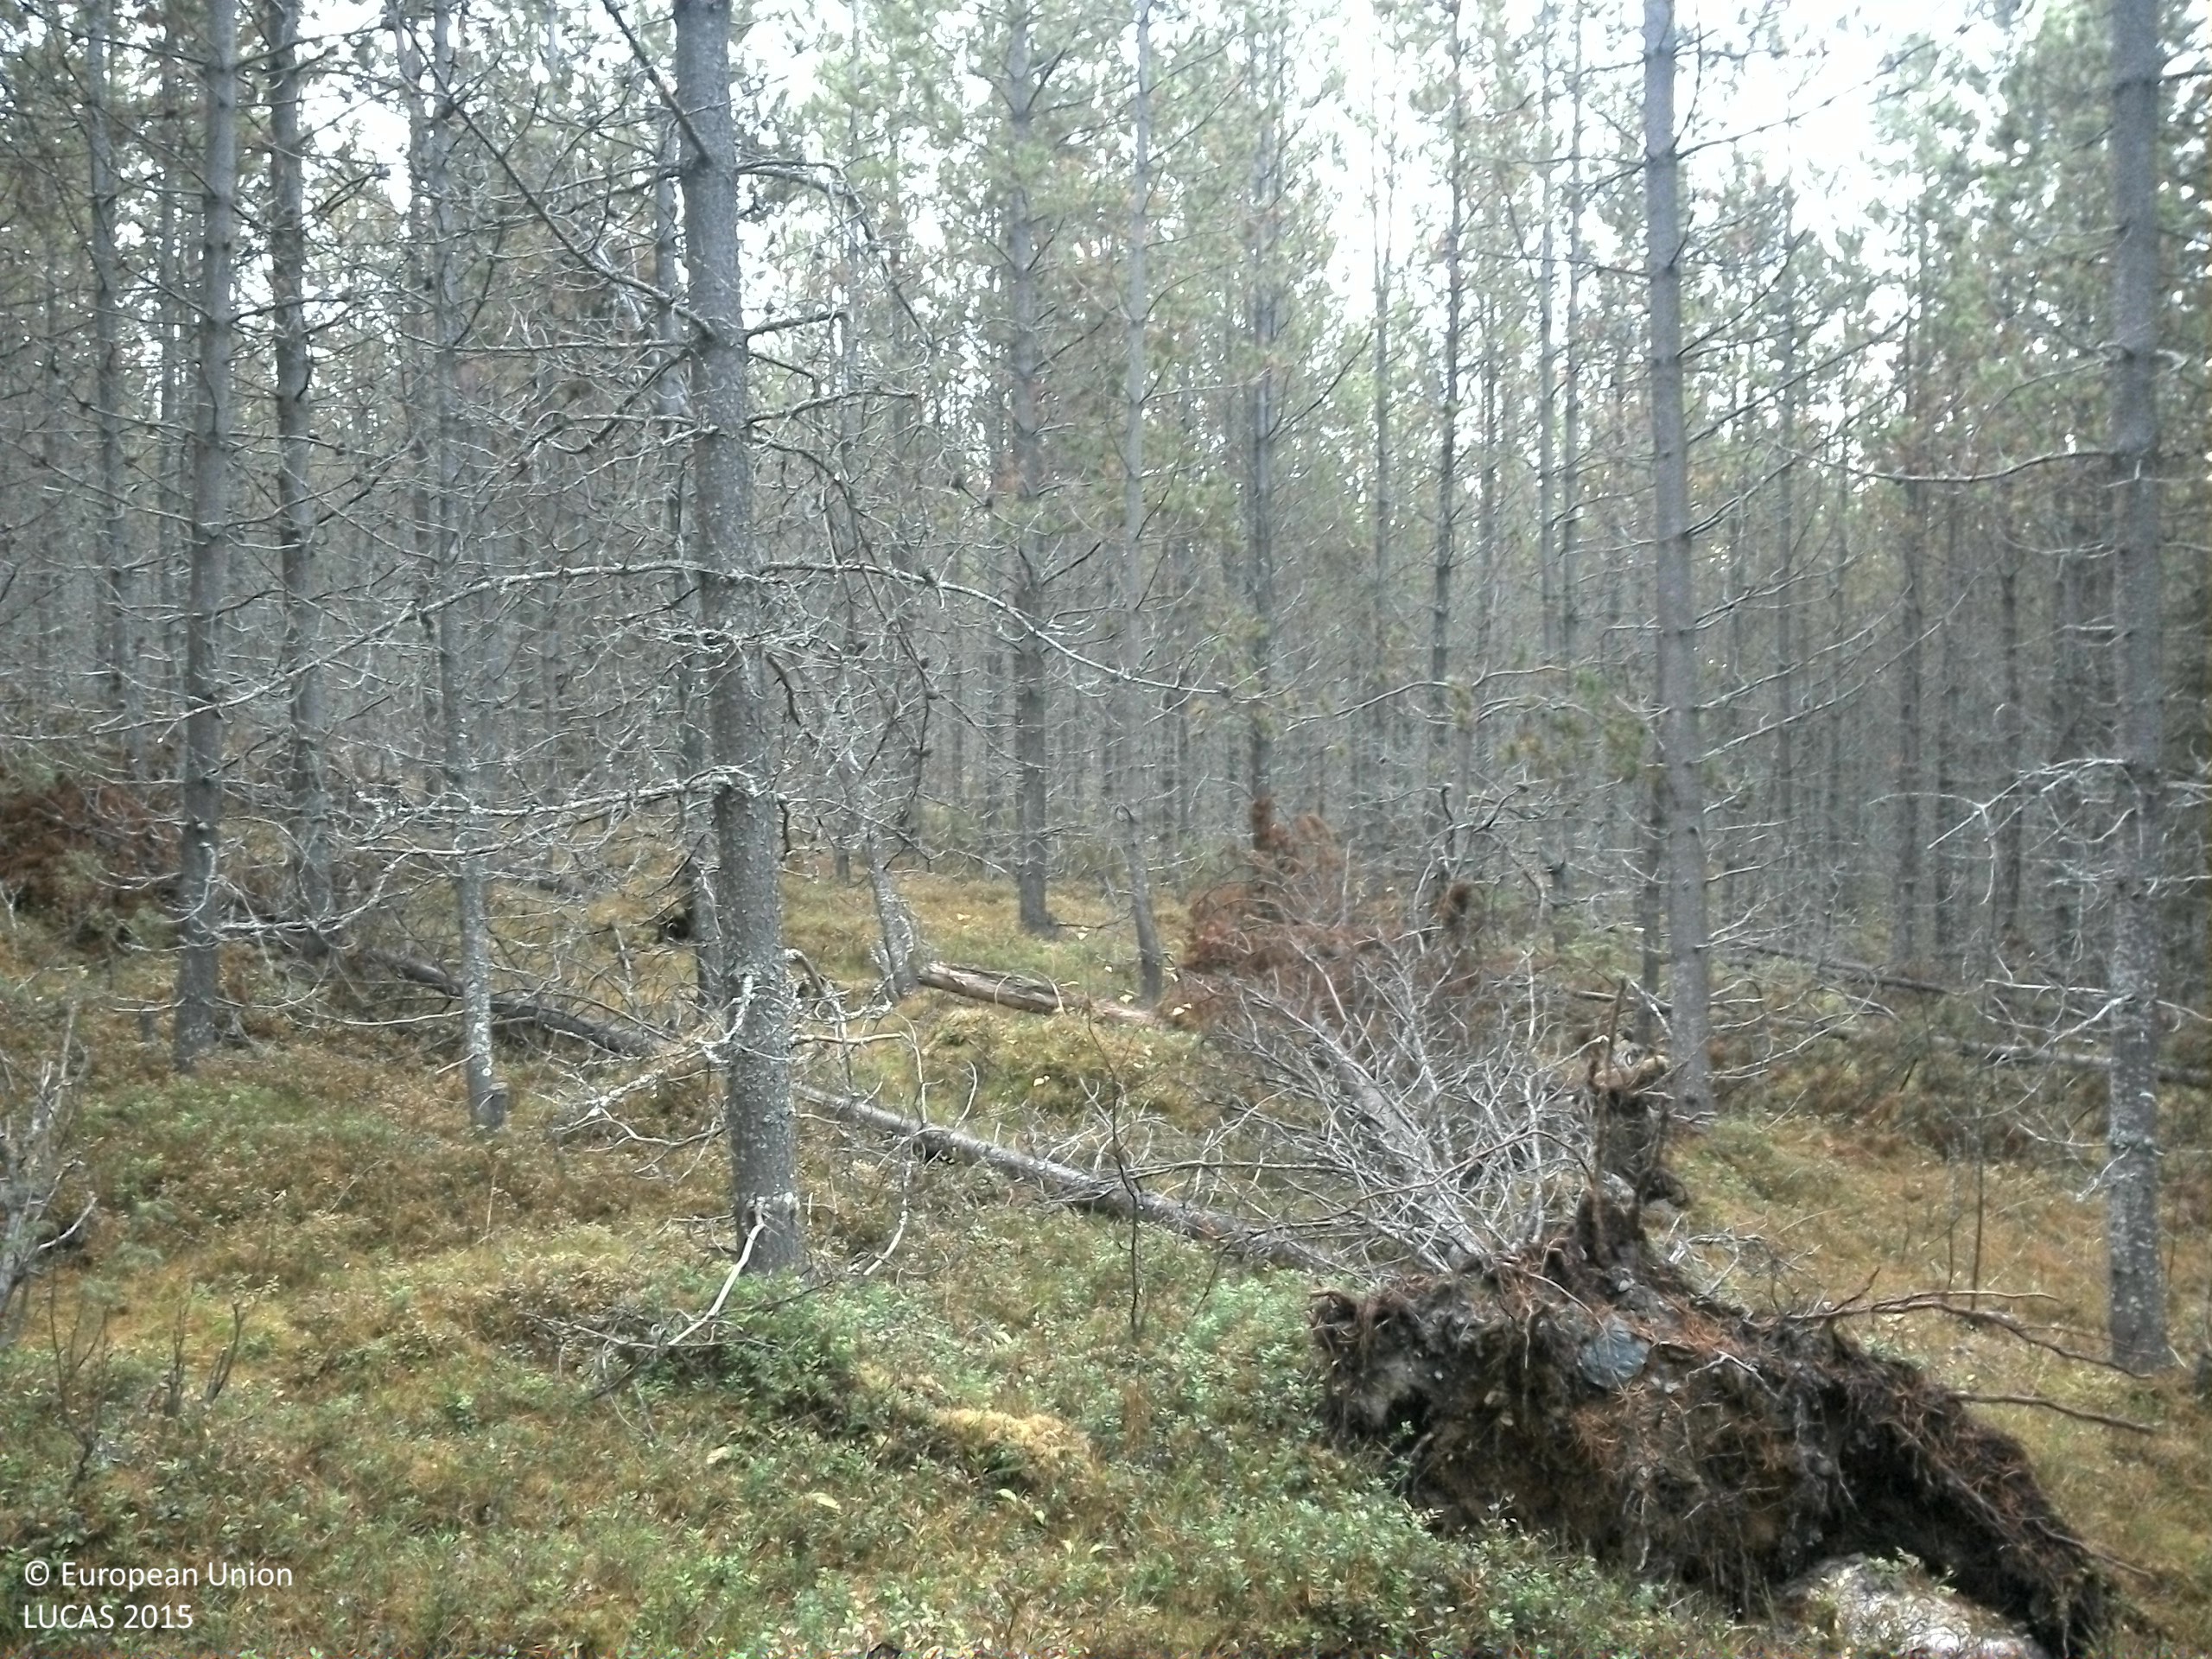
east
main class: Woodland
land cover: Pine dominated coniferous woodland
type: exotic forest
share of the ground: 25 - 50 %
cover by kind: coniferous forest trees 45 %, shrubs 35 %, lichens and mosses 15 %, unconsolidated bare surface 5 %
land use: Forestry
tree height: > 5 m
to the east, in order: Pine dominated coniferous woodland; Spruce dominated mixed woodland; Inland marshes; Spruce dominated mixed woodland; Pine dominated coniferous woodland; Peatbogs; Inland fresh running water; Peatbogs
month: October
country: SE
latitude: 64.3046
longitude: 15.4491
